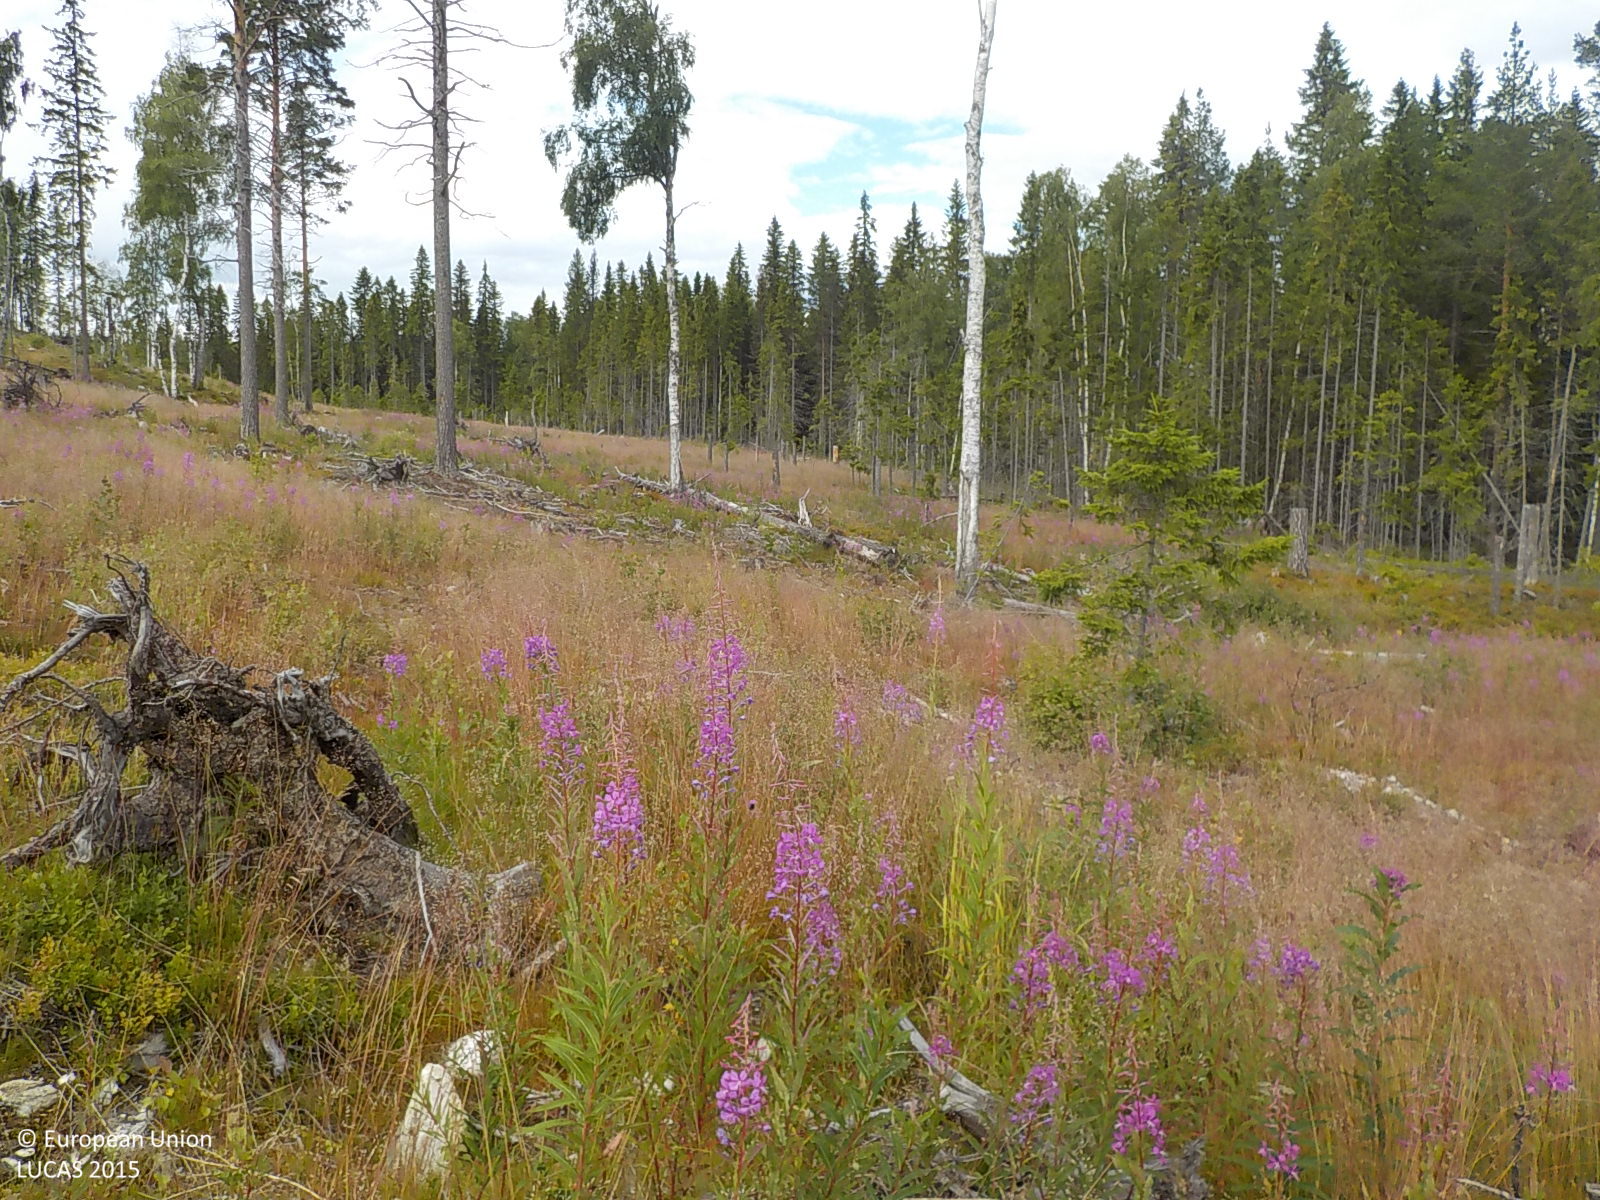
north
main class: Woodland
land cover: Broadleaved woodland
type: boreal forest
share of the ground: 50 - 75 %
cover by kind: broadleaved forest trees 50 %, herbaceous plants 45 %, shrubs 5 %
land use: Forestry
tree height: < 5 m
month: July
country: SE
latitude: 63.2657
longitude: 17.3675
